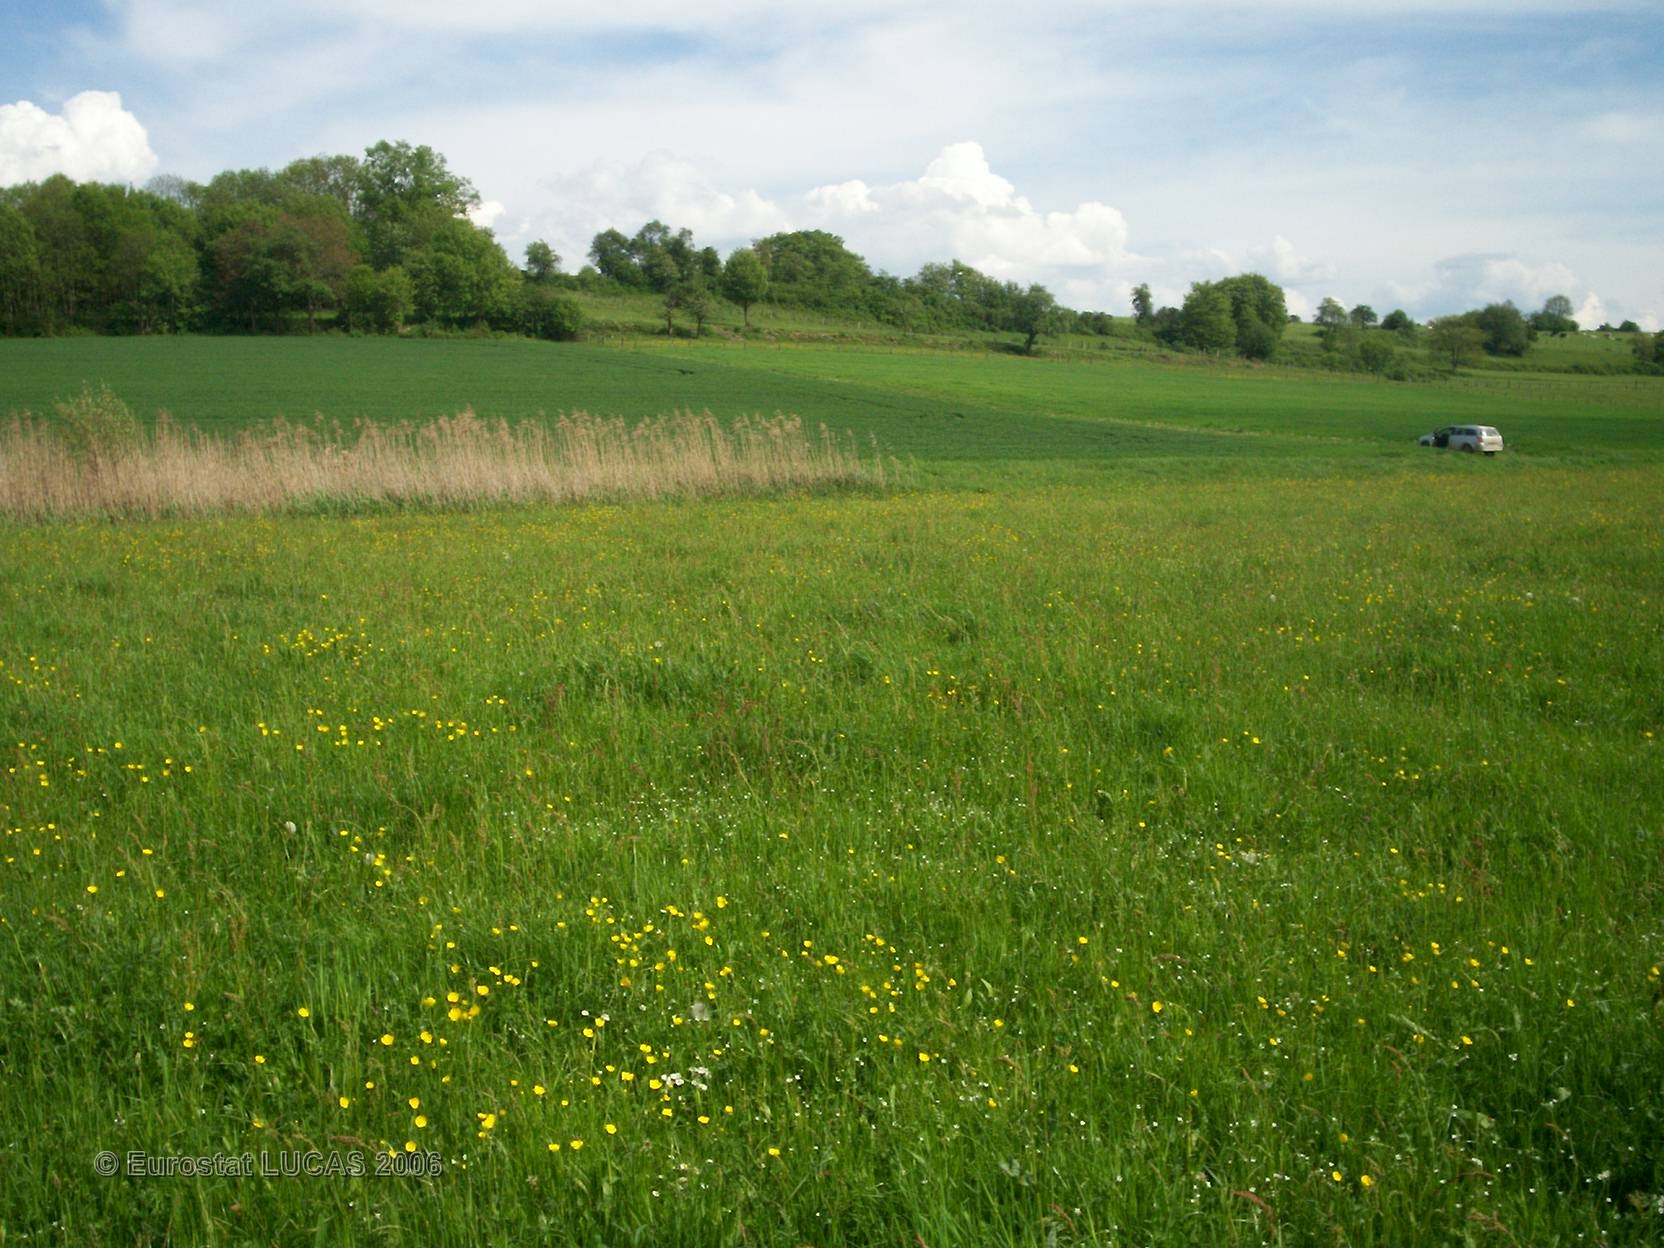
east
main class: Grassland
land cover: Grassland without tree/shrub cover
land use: Agriculture (excluding fallow land and kitchen gardens)
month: May
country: FR
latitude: 48.8328
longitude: 7.0716
